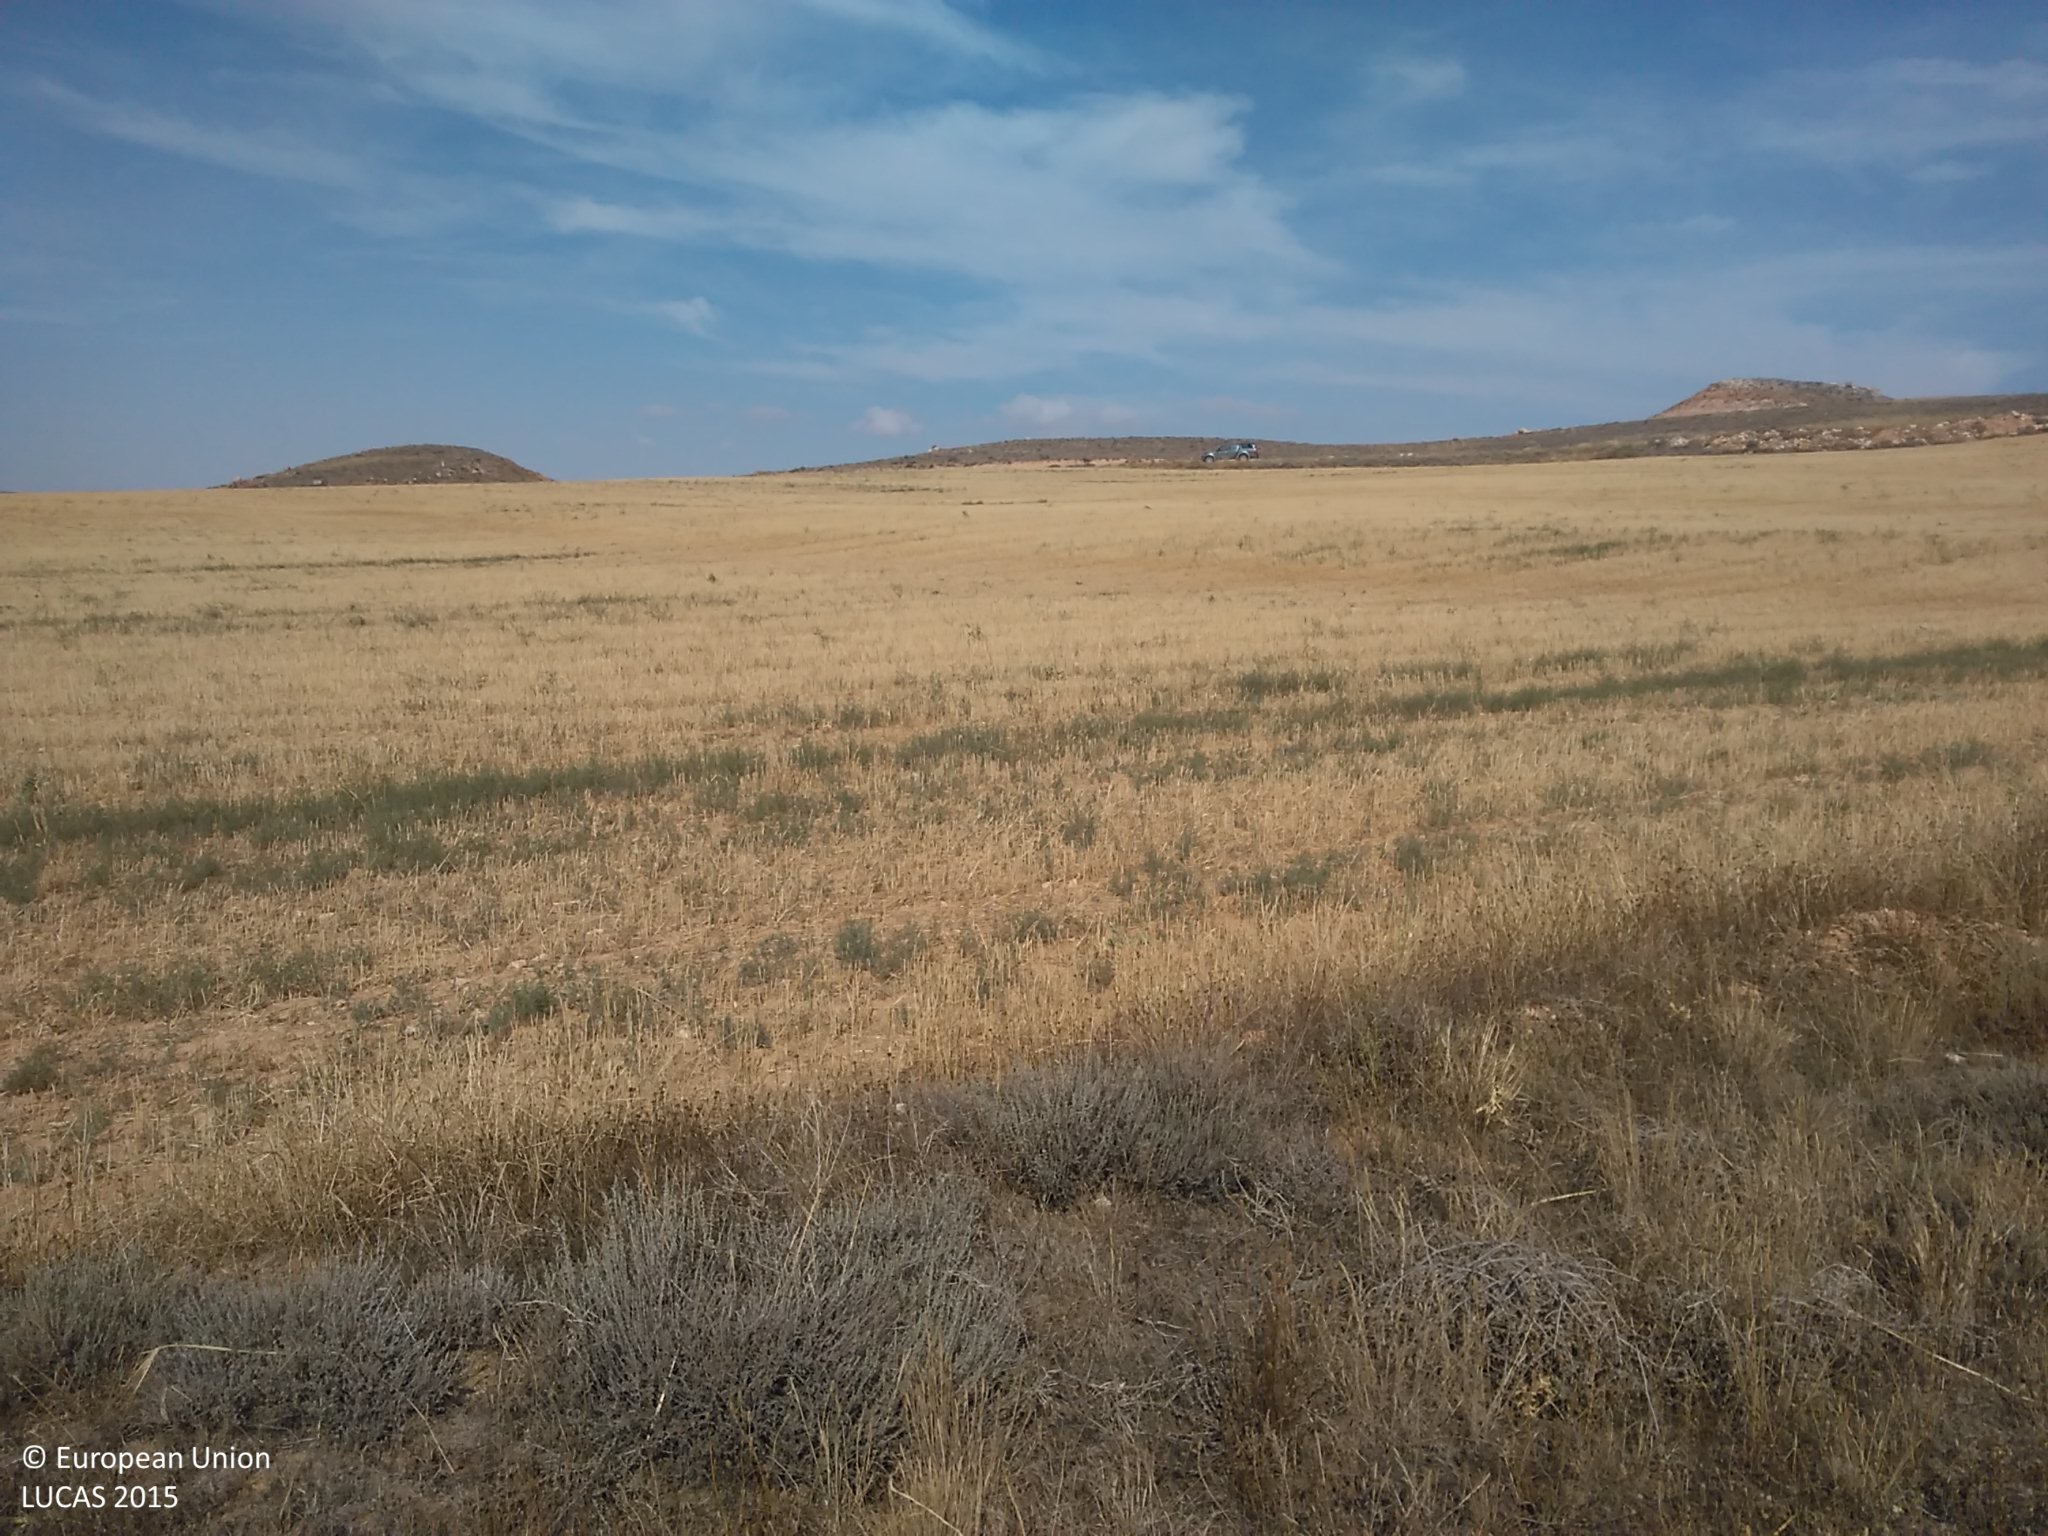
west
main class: Shrubland
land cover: Shrubland without tree cover
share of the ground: 10 - 25 %
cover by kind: herbaceous plants 70 %, shrubs 20 %, unconsolidated bare surface 10 %
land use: Semi-natural and natural areas not in use
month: July
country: ES
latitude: 41.3289
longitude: -2.2056
